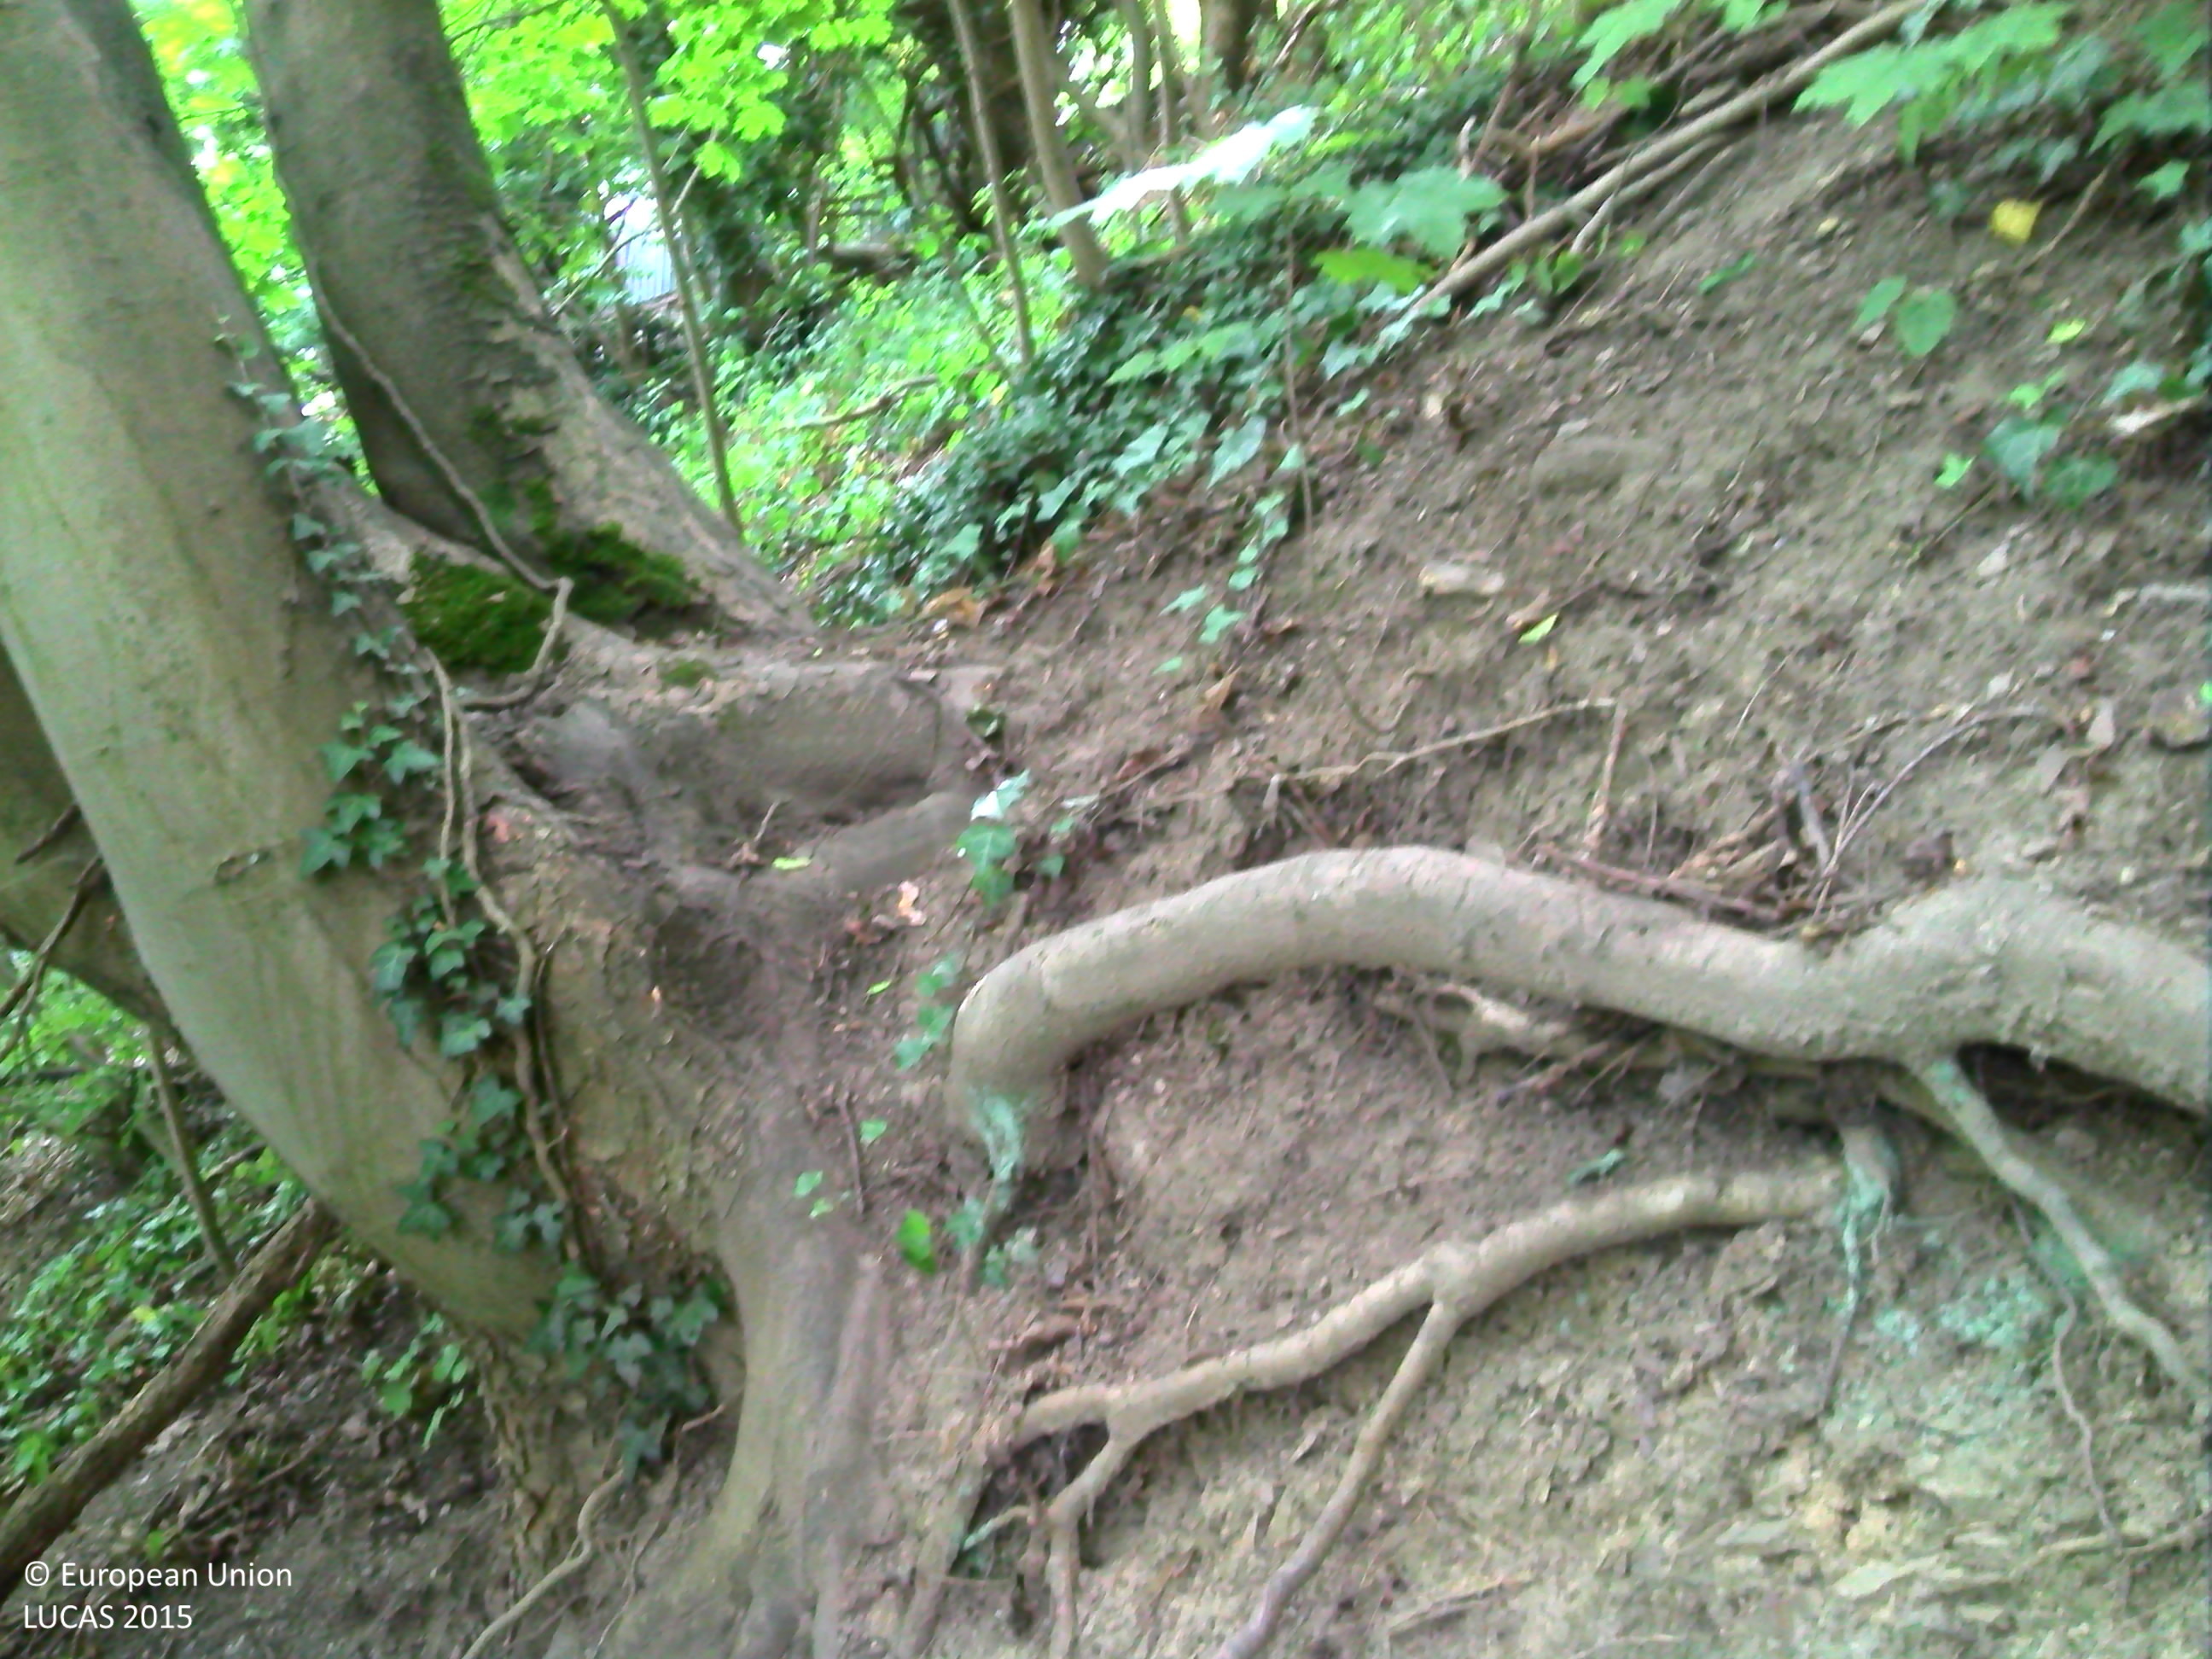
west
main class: Woodland
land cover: Broadleaved woodland
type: mesophytic deciduous forest
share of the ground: > 75 %
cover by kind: broadleaved forest trees 80 %, herbaceous plants 20 %
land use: Forestry
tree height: > 5 m
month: July
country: BE
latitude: 50.5952
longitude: 5.8596
